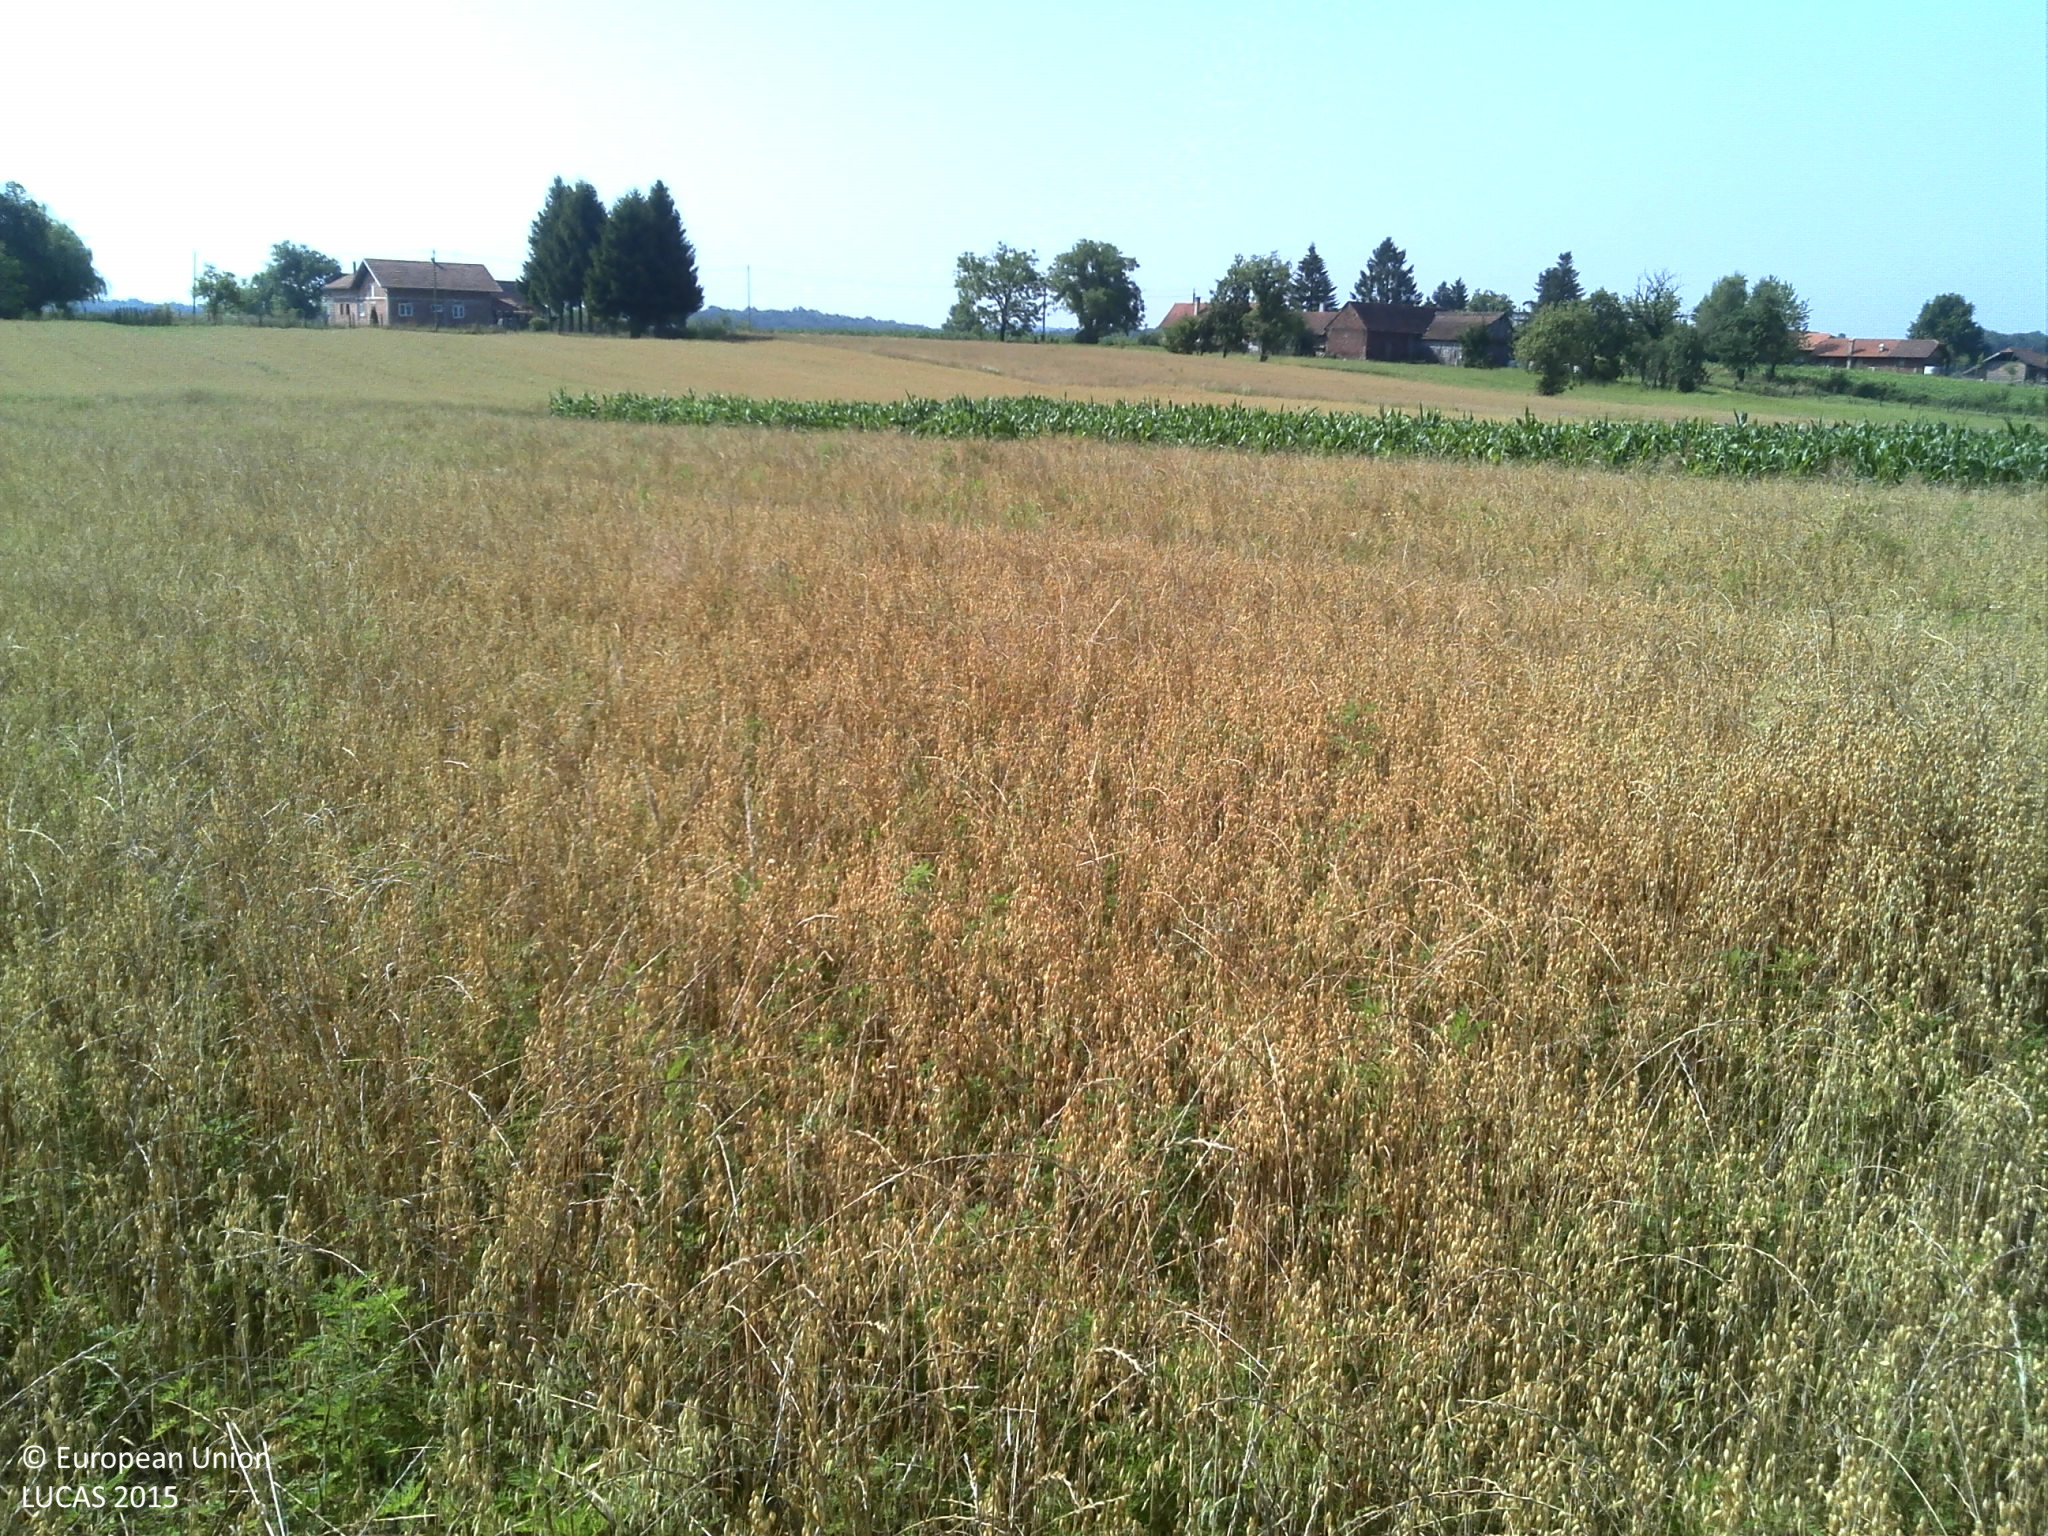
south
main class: Cropland
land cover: Oats
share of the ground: > 75 %
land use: Agriculture (excluding fallow land and kitchen gardens)
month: July
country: HR
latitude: 45.7712
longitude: 16.5447
